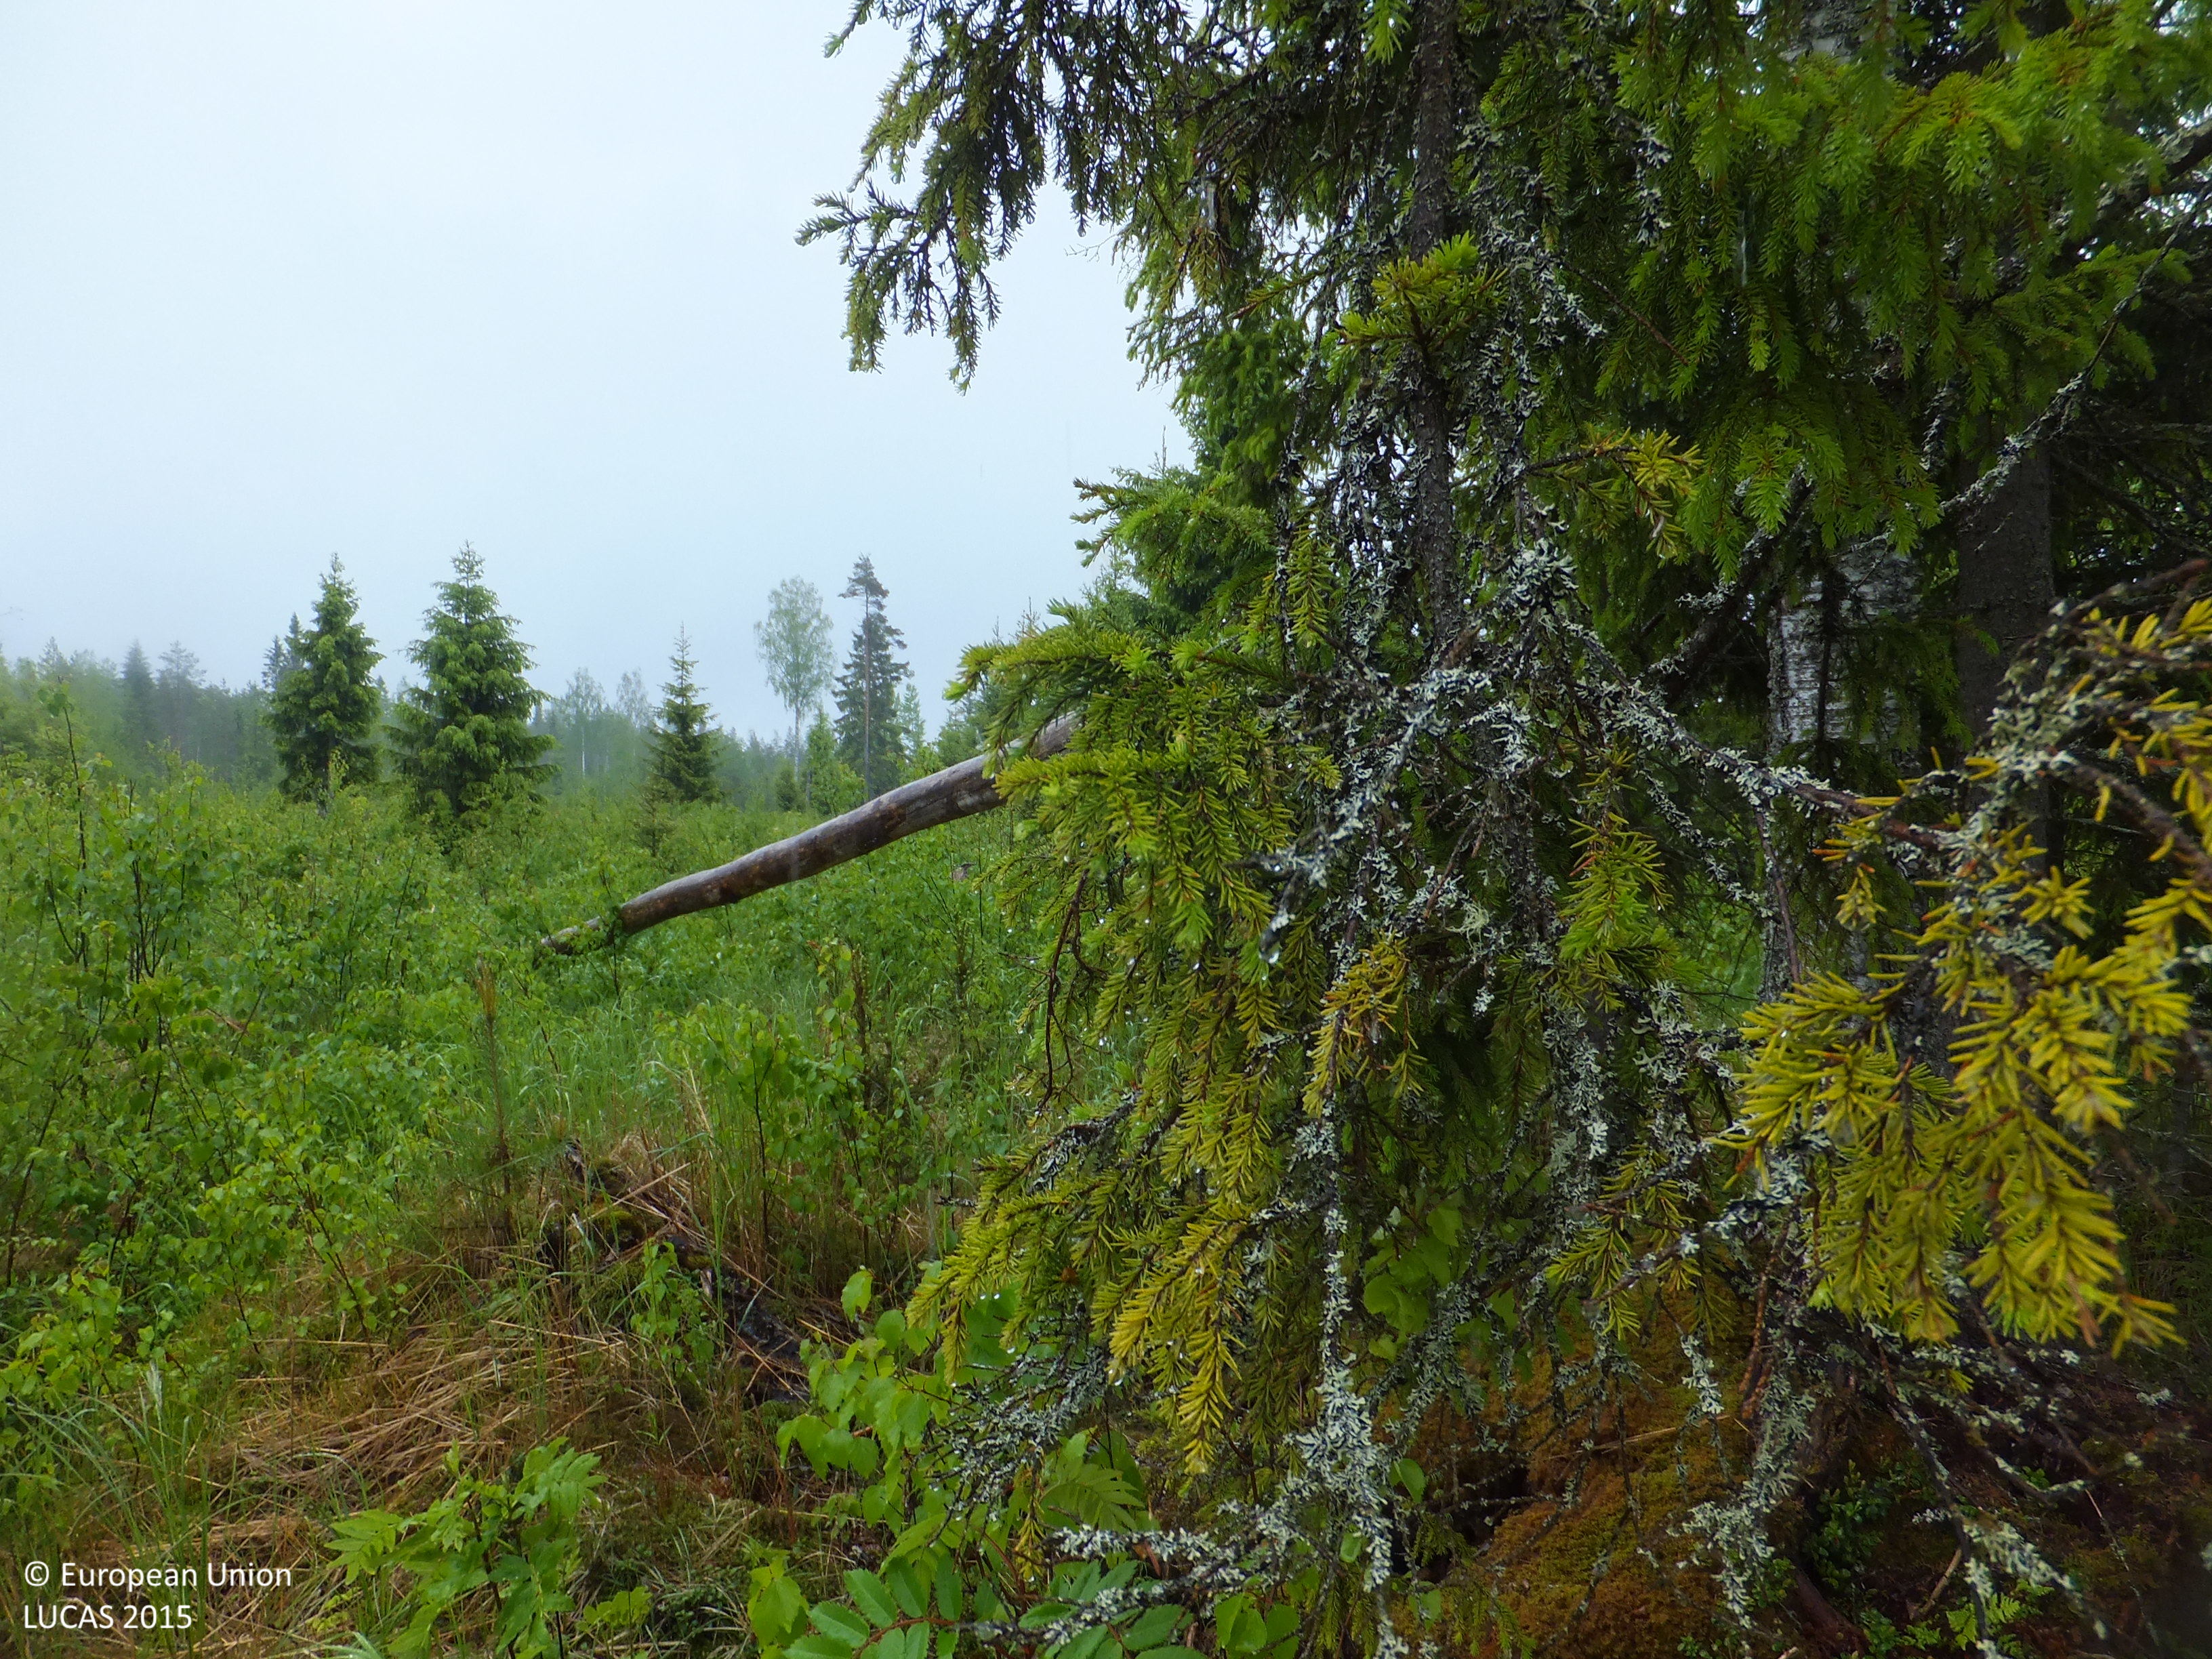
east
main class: Woodland
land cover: Spruce dominated mixed woodland
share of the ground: 50 - 75 %
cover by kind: broadleaved forest trees 40 %, herbaceous plants 30 %, coniferous forest trees 20 %, lichens and mosses 10 %
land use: Forestry
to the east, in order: Spruce dominated mixed woodland; Ditches and canals; Spruce dominated mixed woodland; Ditches and canals; Spruce dominated mixed woodland; Rivers and streams; Grass margins; Paved roads, cycling and walking lanes; Grass margins; Spruce dominated coniferous woodland; Ditches and canals; Other mixed woodland; Spruce dominated coniferous woodland; Spruce dominated mixed woodland; Ditches and canals; Other coniferous woodland; Tracks; Other coniferous woodland
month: June
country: FI
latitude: 63.7372
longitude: 24.9752
